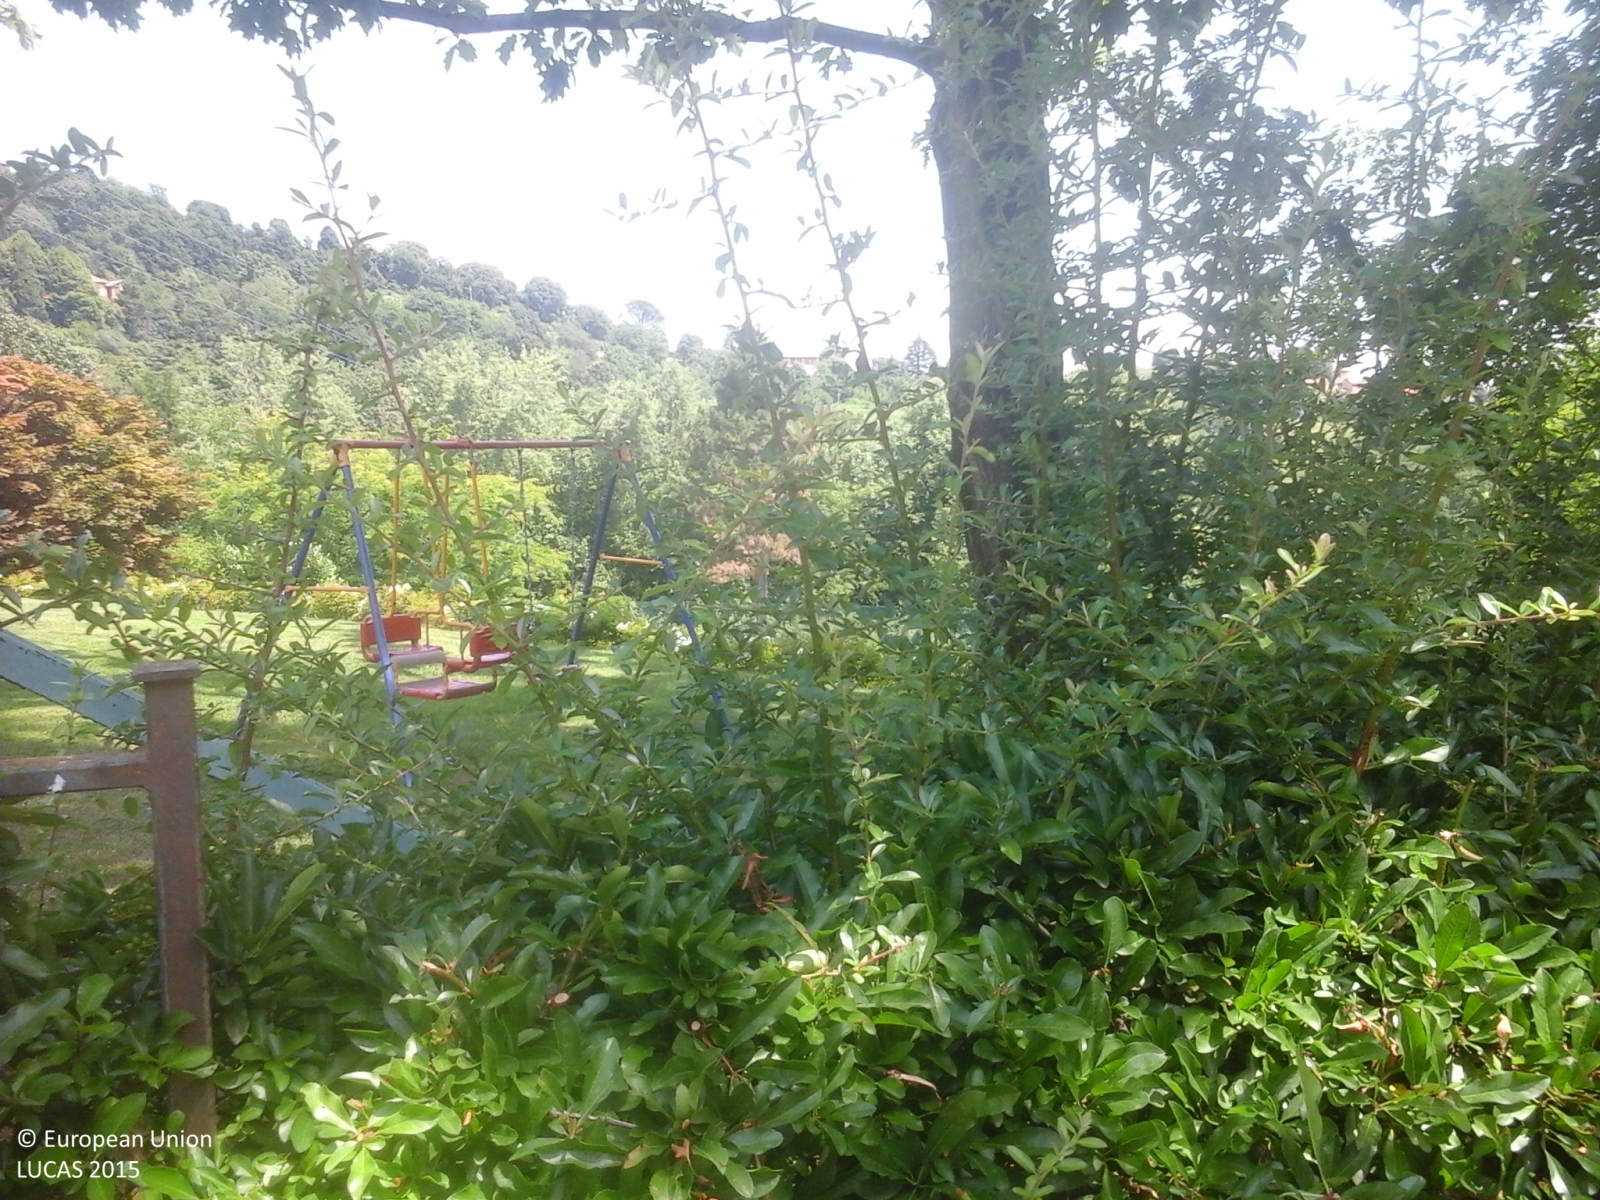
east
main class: Woodland
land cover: Broadleaved woodland
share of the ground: > 75 %
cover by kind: broadleaved forest trees 85 %, shrubs 10 %, herbaceous plants 5 %
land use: Residential
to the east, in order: Broadleaved woodland; Artificial constructions in urban areas; Broadleaved woodland; Grassland without tree/shrub cover; Broadleaved woodland; Electric lines; Broadleaved woodland; Inland fresh running water; Broadleaved woodland; Electric lines; Grassland without tree/shrub cover
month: June
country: IT
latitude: 45.7008
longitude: 9.3717
